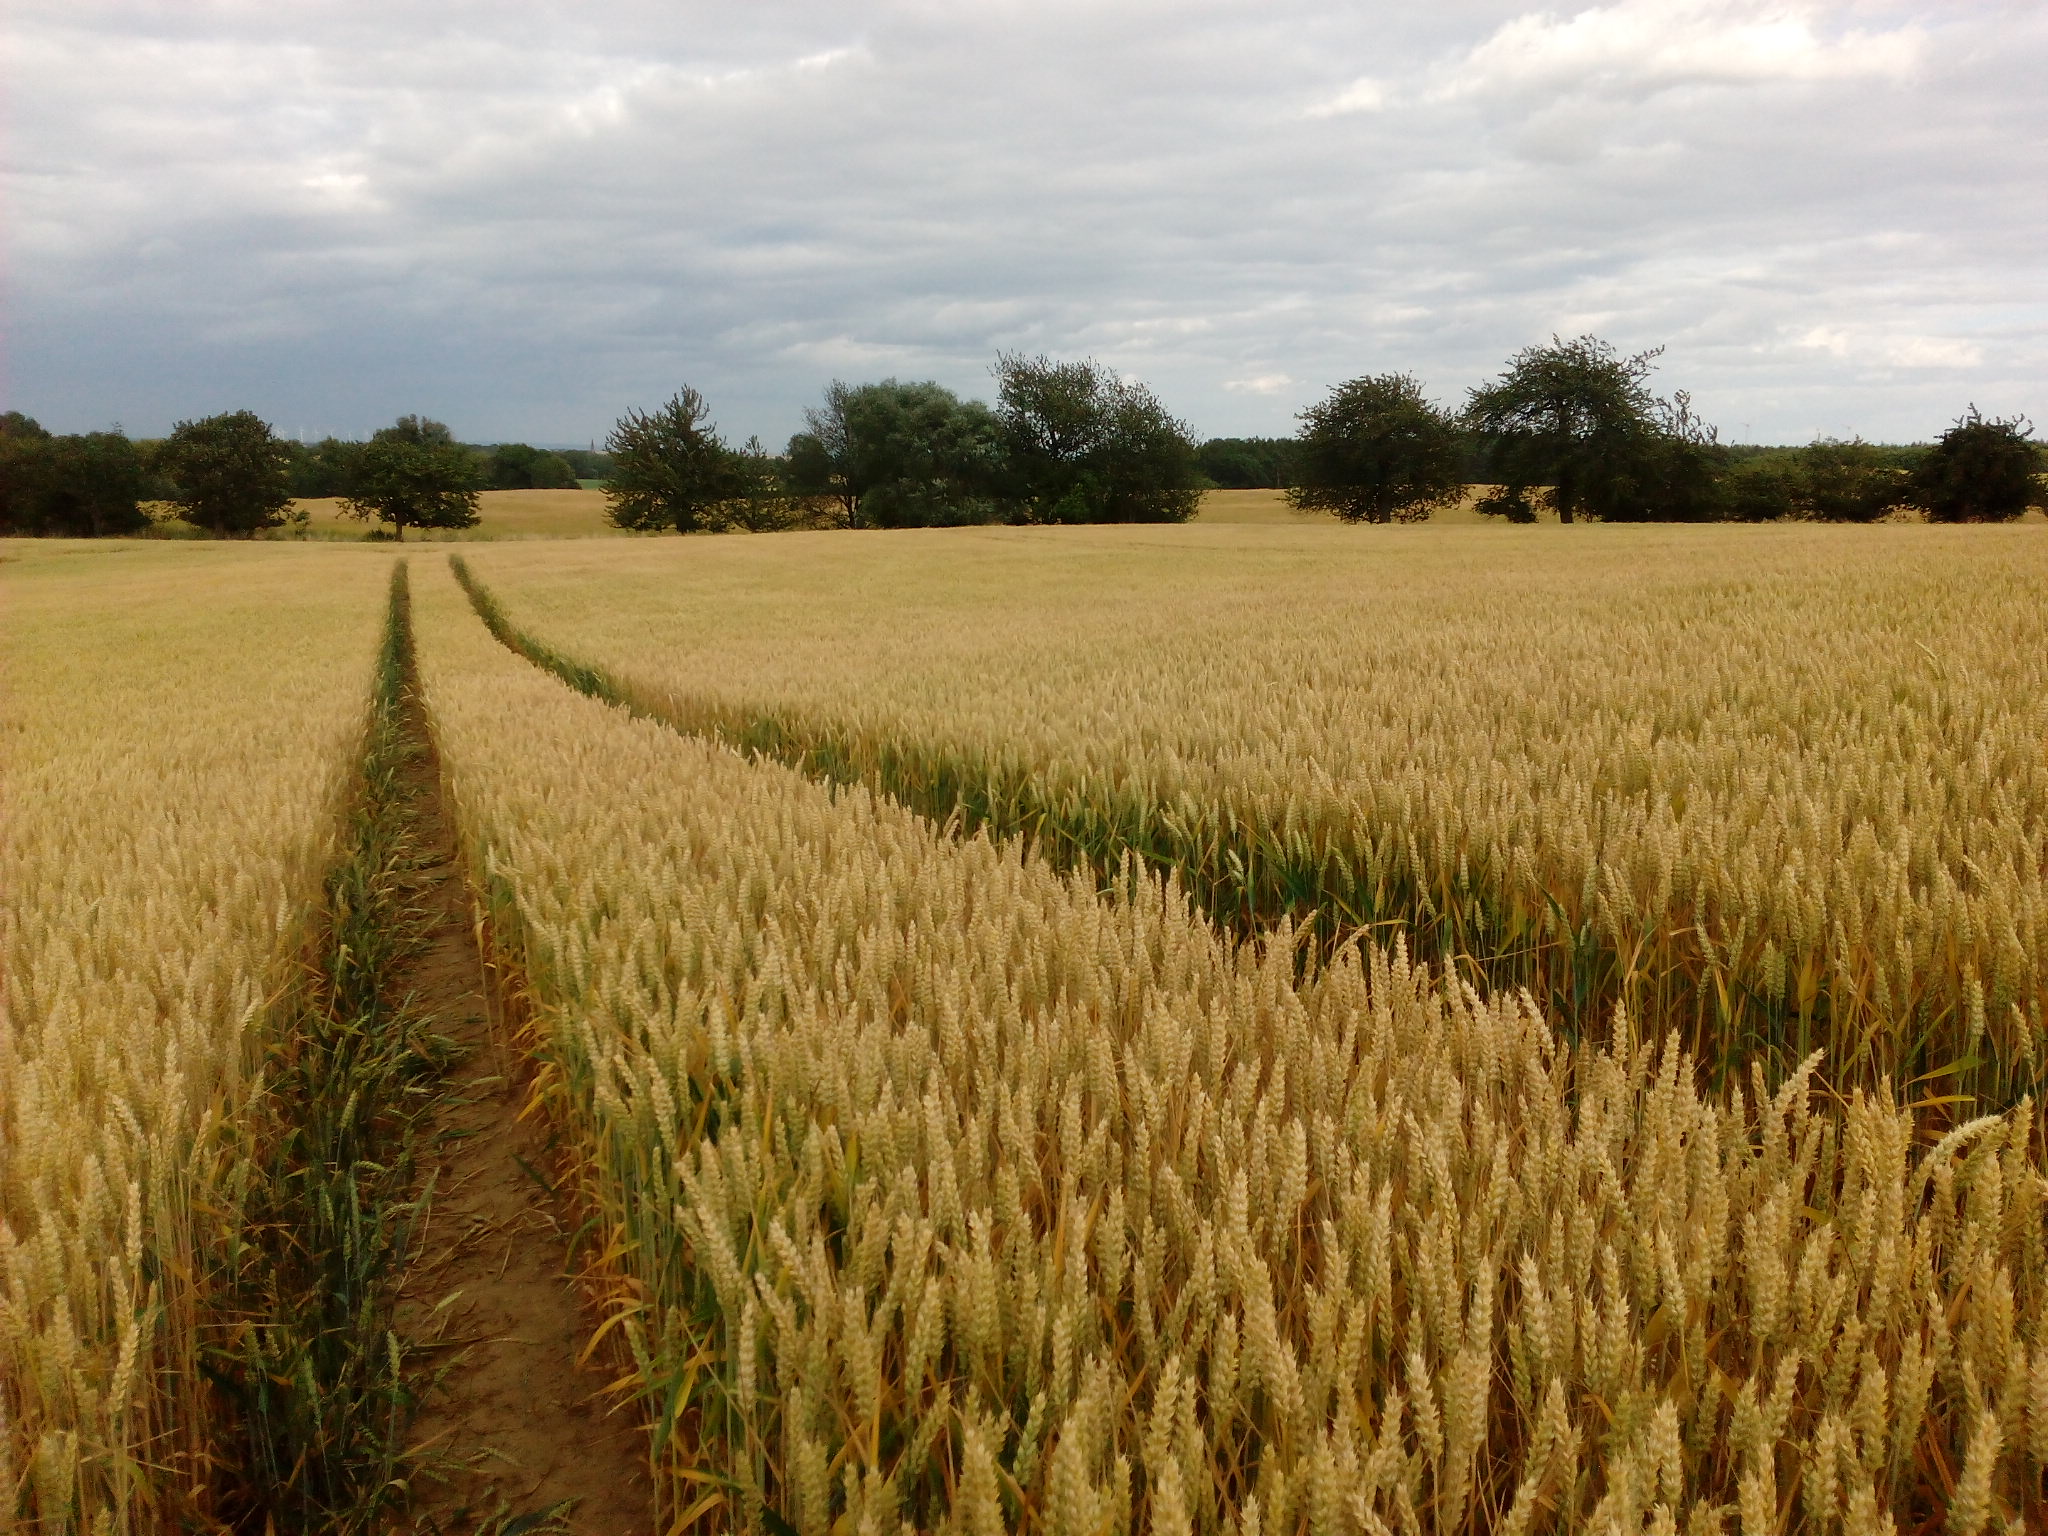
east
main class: Cropland
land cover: Common wheat
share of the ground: > 75 %
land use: Agriculture (excluding fallow land and kitchen gardens)
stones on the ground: < 10 %
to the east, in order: Common wheat; Grassland without tree/shrub cover; Lines of trees; Grassland without tree/shrub cover; Rape and turnip rape
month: July
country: DE
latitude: 53.2936
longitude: 14.1864
